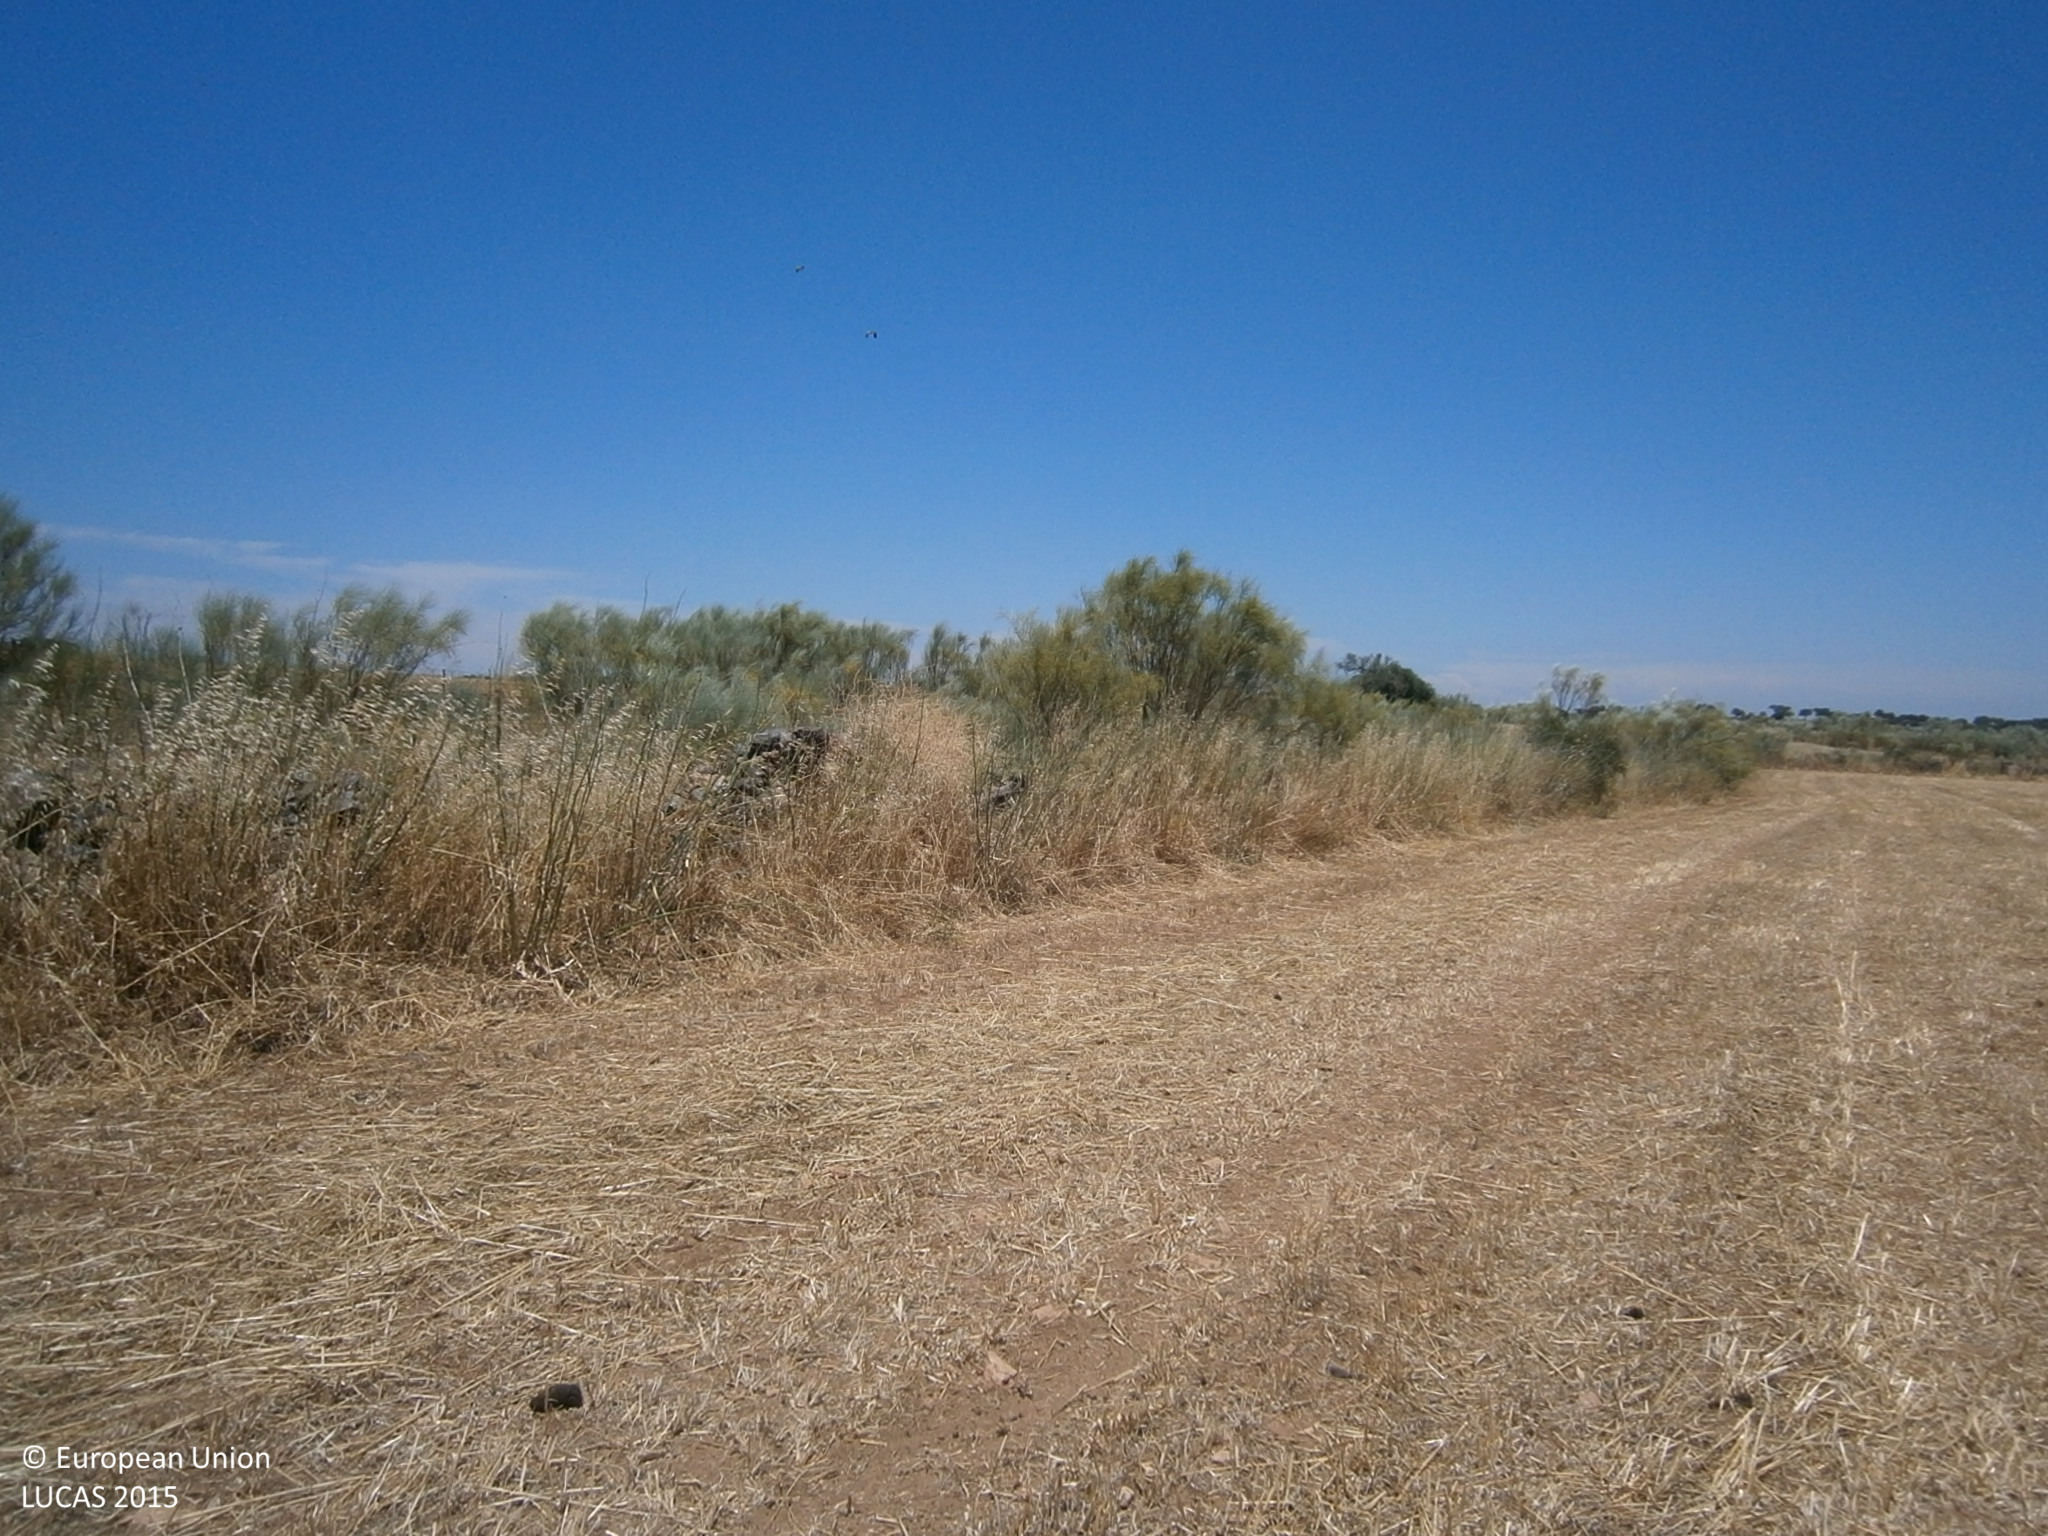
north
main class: Cropland
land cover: Mixed cereals for fodder
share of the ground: > 75 %
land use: Agriculture (excluding fallow land and kitchen gardens)
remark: Harvested field
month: June
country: ES
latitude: 38.6641
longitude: -6.8775
